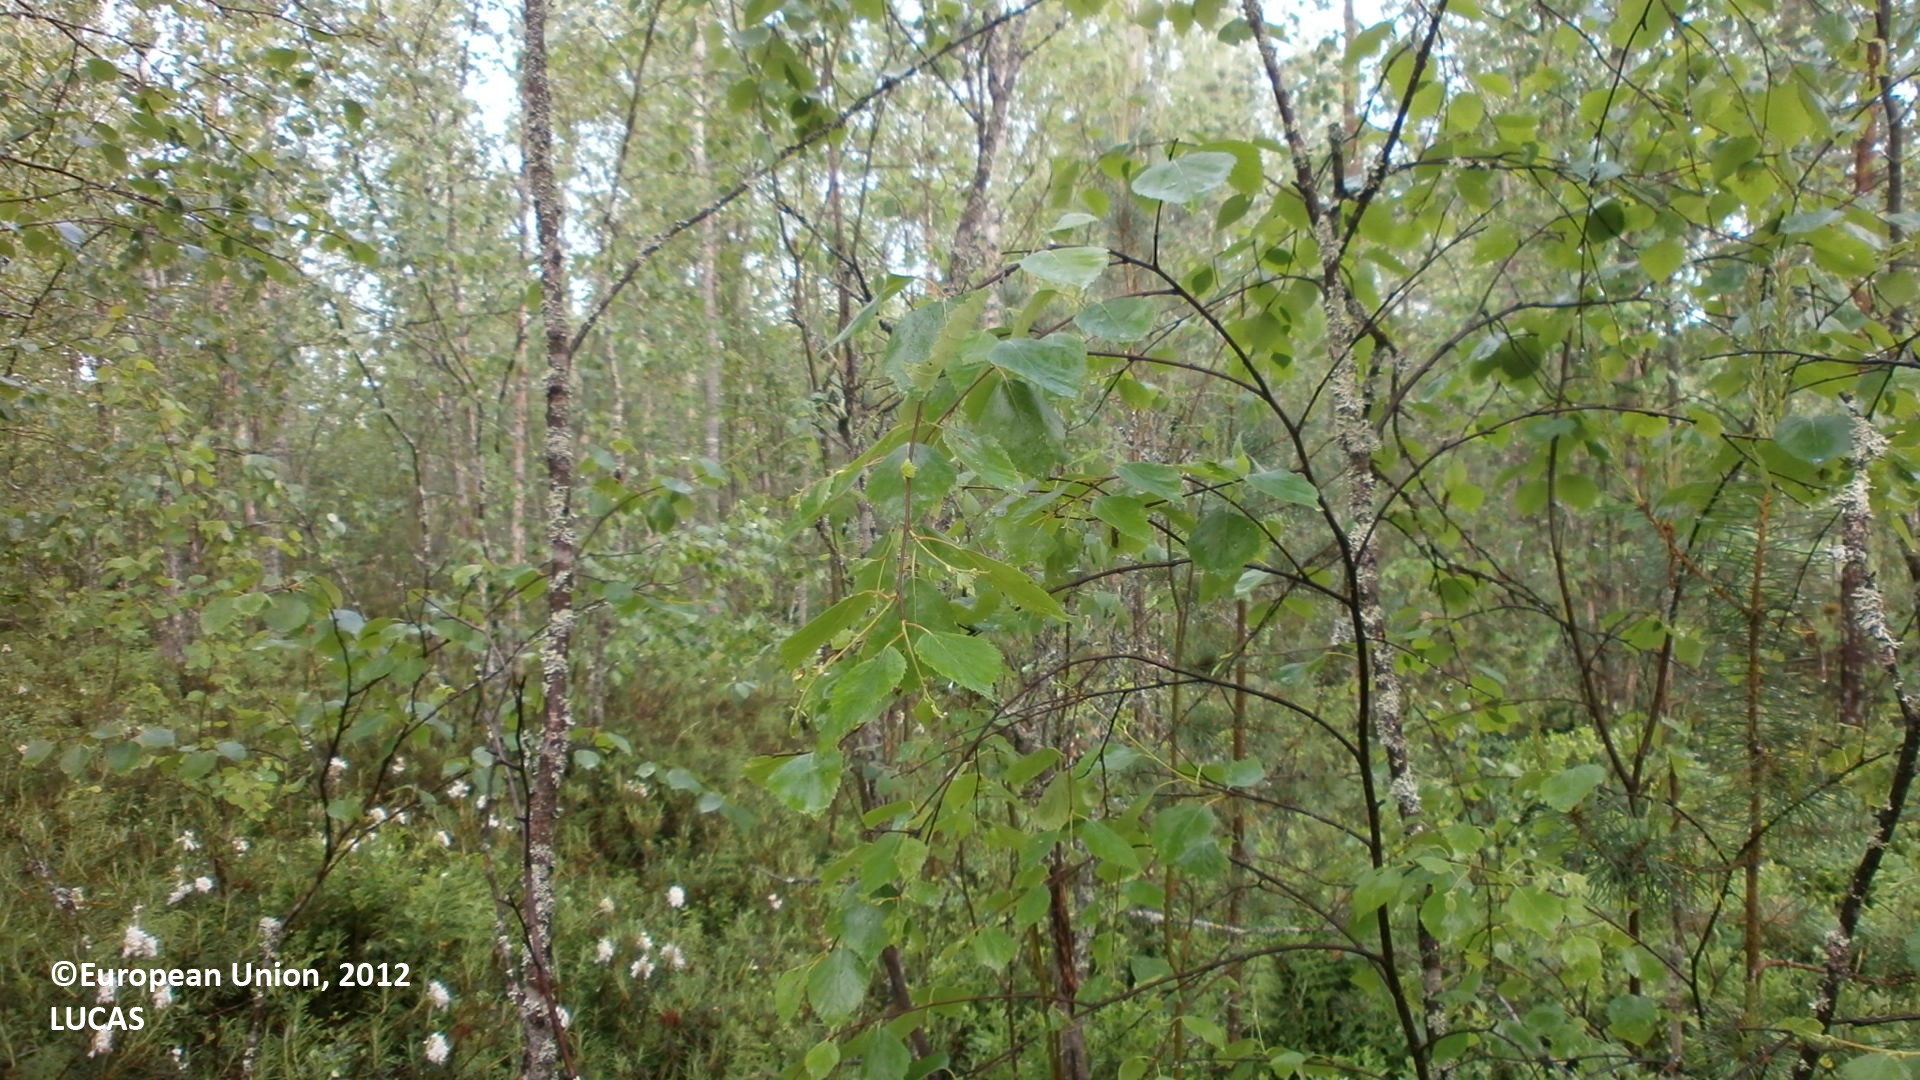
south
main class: Woodland
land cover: Broadleaved woodland
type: boreal forest
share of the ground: > 75 %
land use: Forestry
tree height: > 5 m
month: June
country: FI
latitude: 64.7861
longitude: 25.2068
